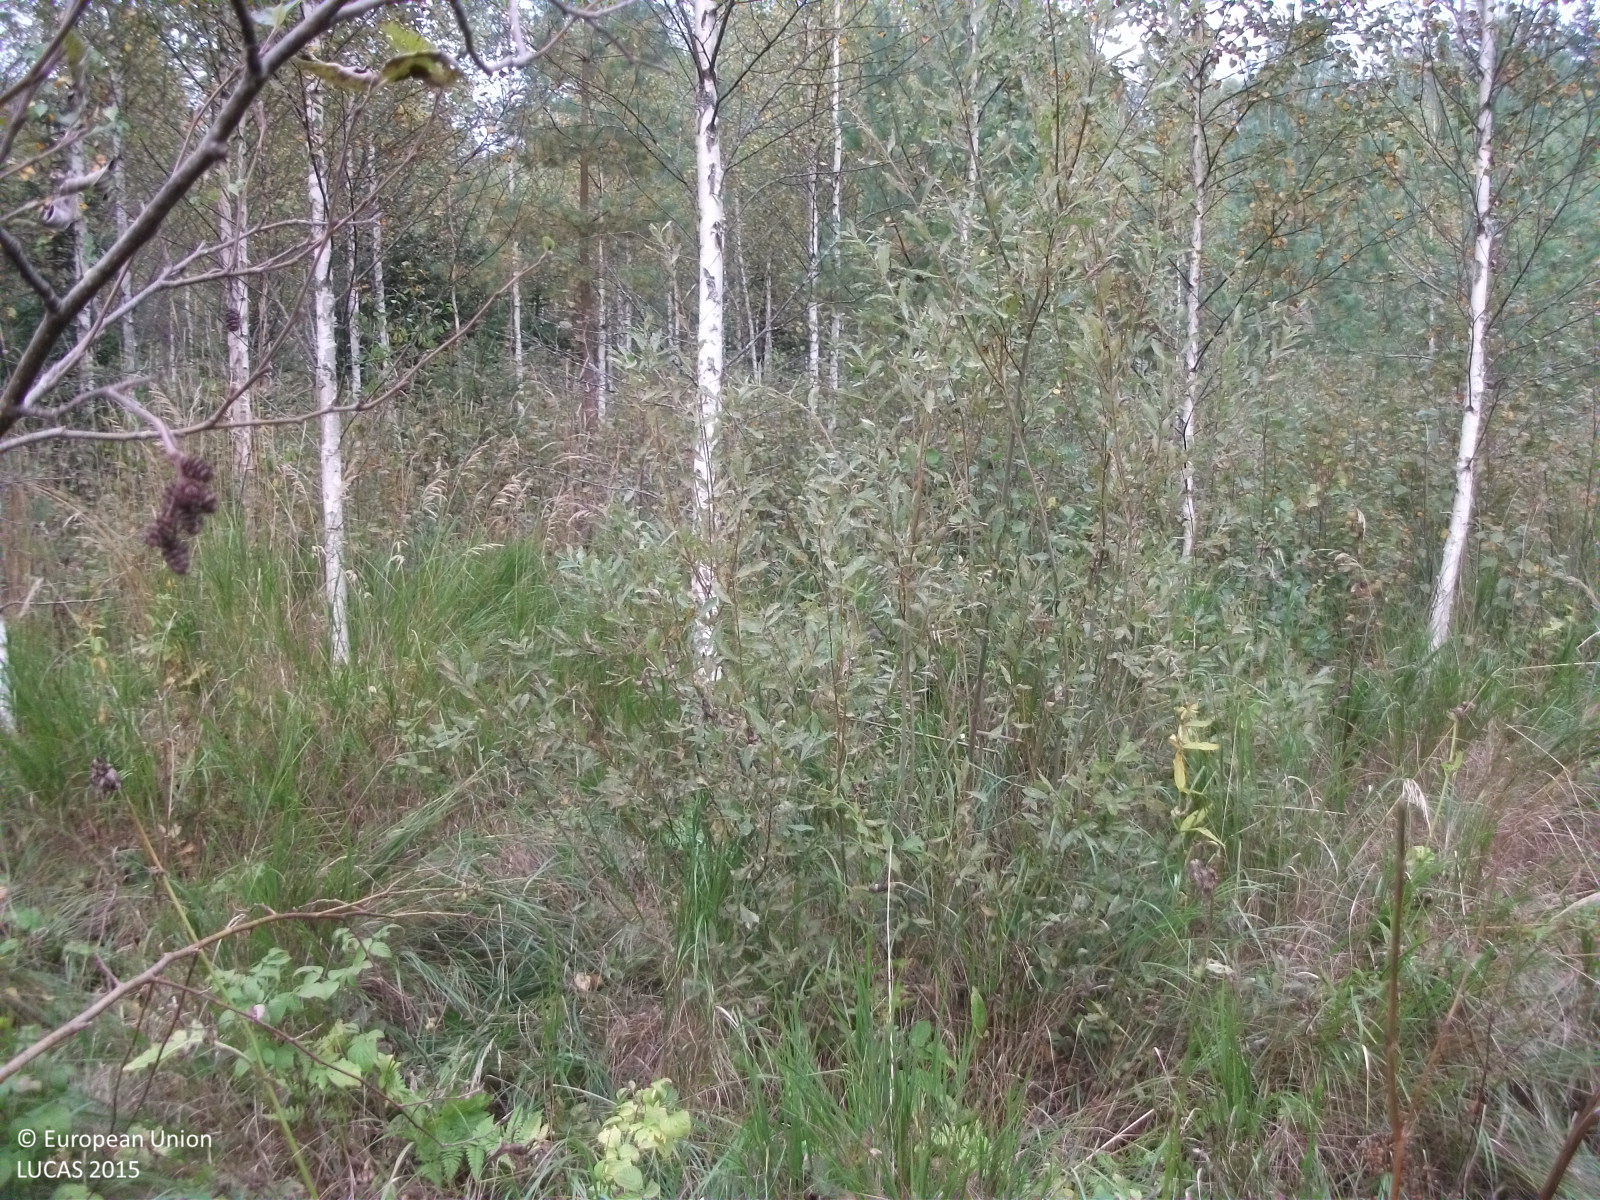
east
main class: Woodland
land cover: Other mixed woodland
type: hemiboreal forest and nemoral coniferous forest and mixed broadleaved-coniferous forest
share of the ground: 50 - 75 %
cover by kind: broadleaved forest trees 45 %, coniferous forest trees 25 %, herbaceous plants 20 %, shrubs 10 %
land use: Forestry
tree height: > 5 m
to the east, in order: Other mixed woodland; Broadleaved woodland; Spruce dominated mixed woodland; Shrubland with sparse tree cover; Other mixed woodland; Spruce dominated mixed woodland
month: September
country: LV
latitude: 57.7644
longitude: 24.5979
